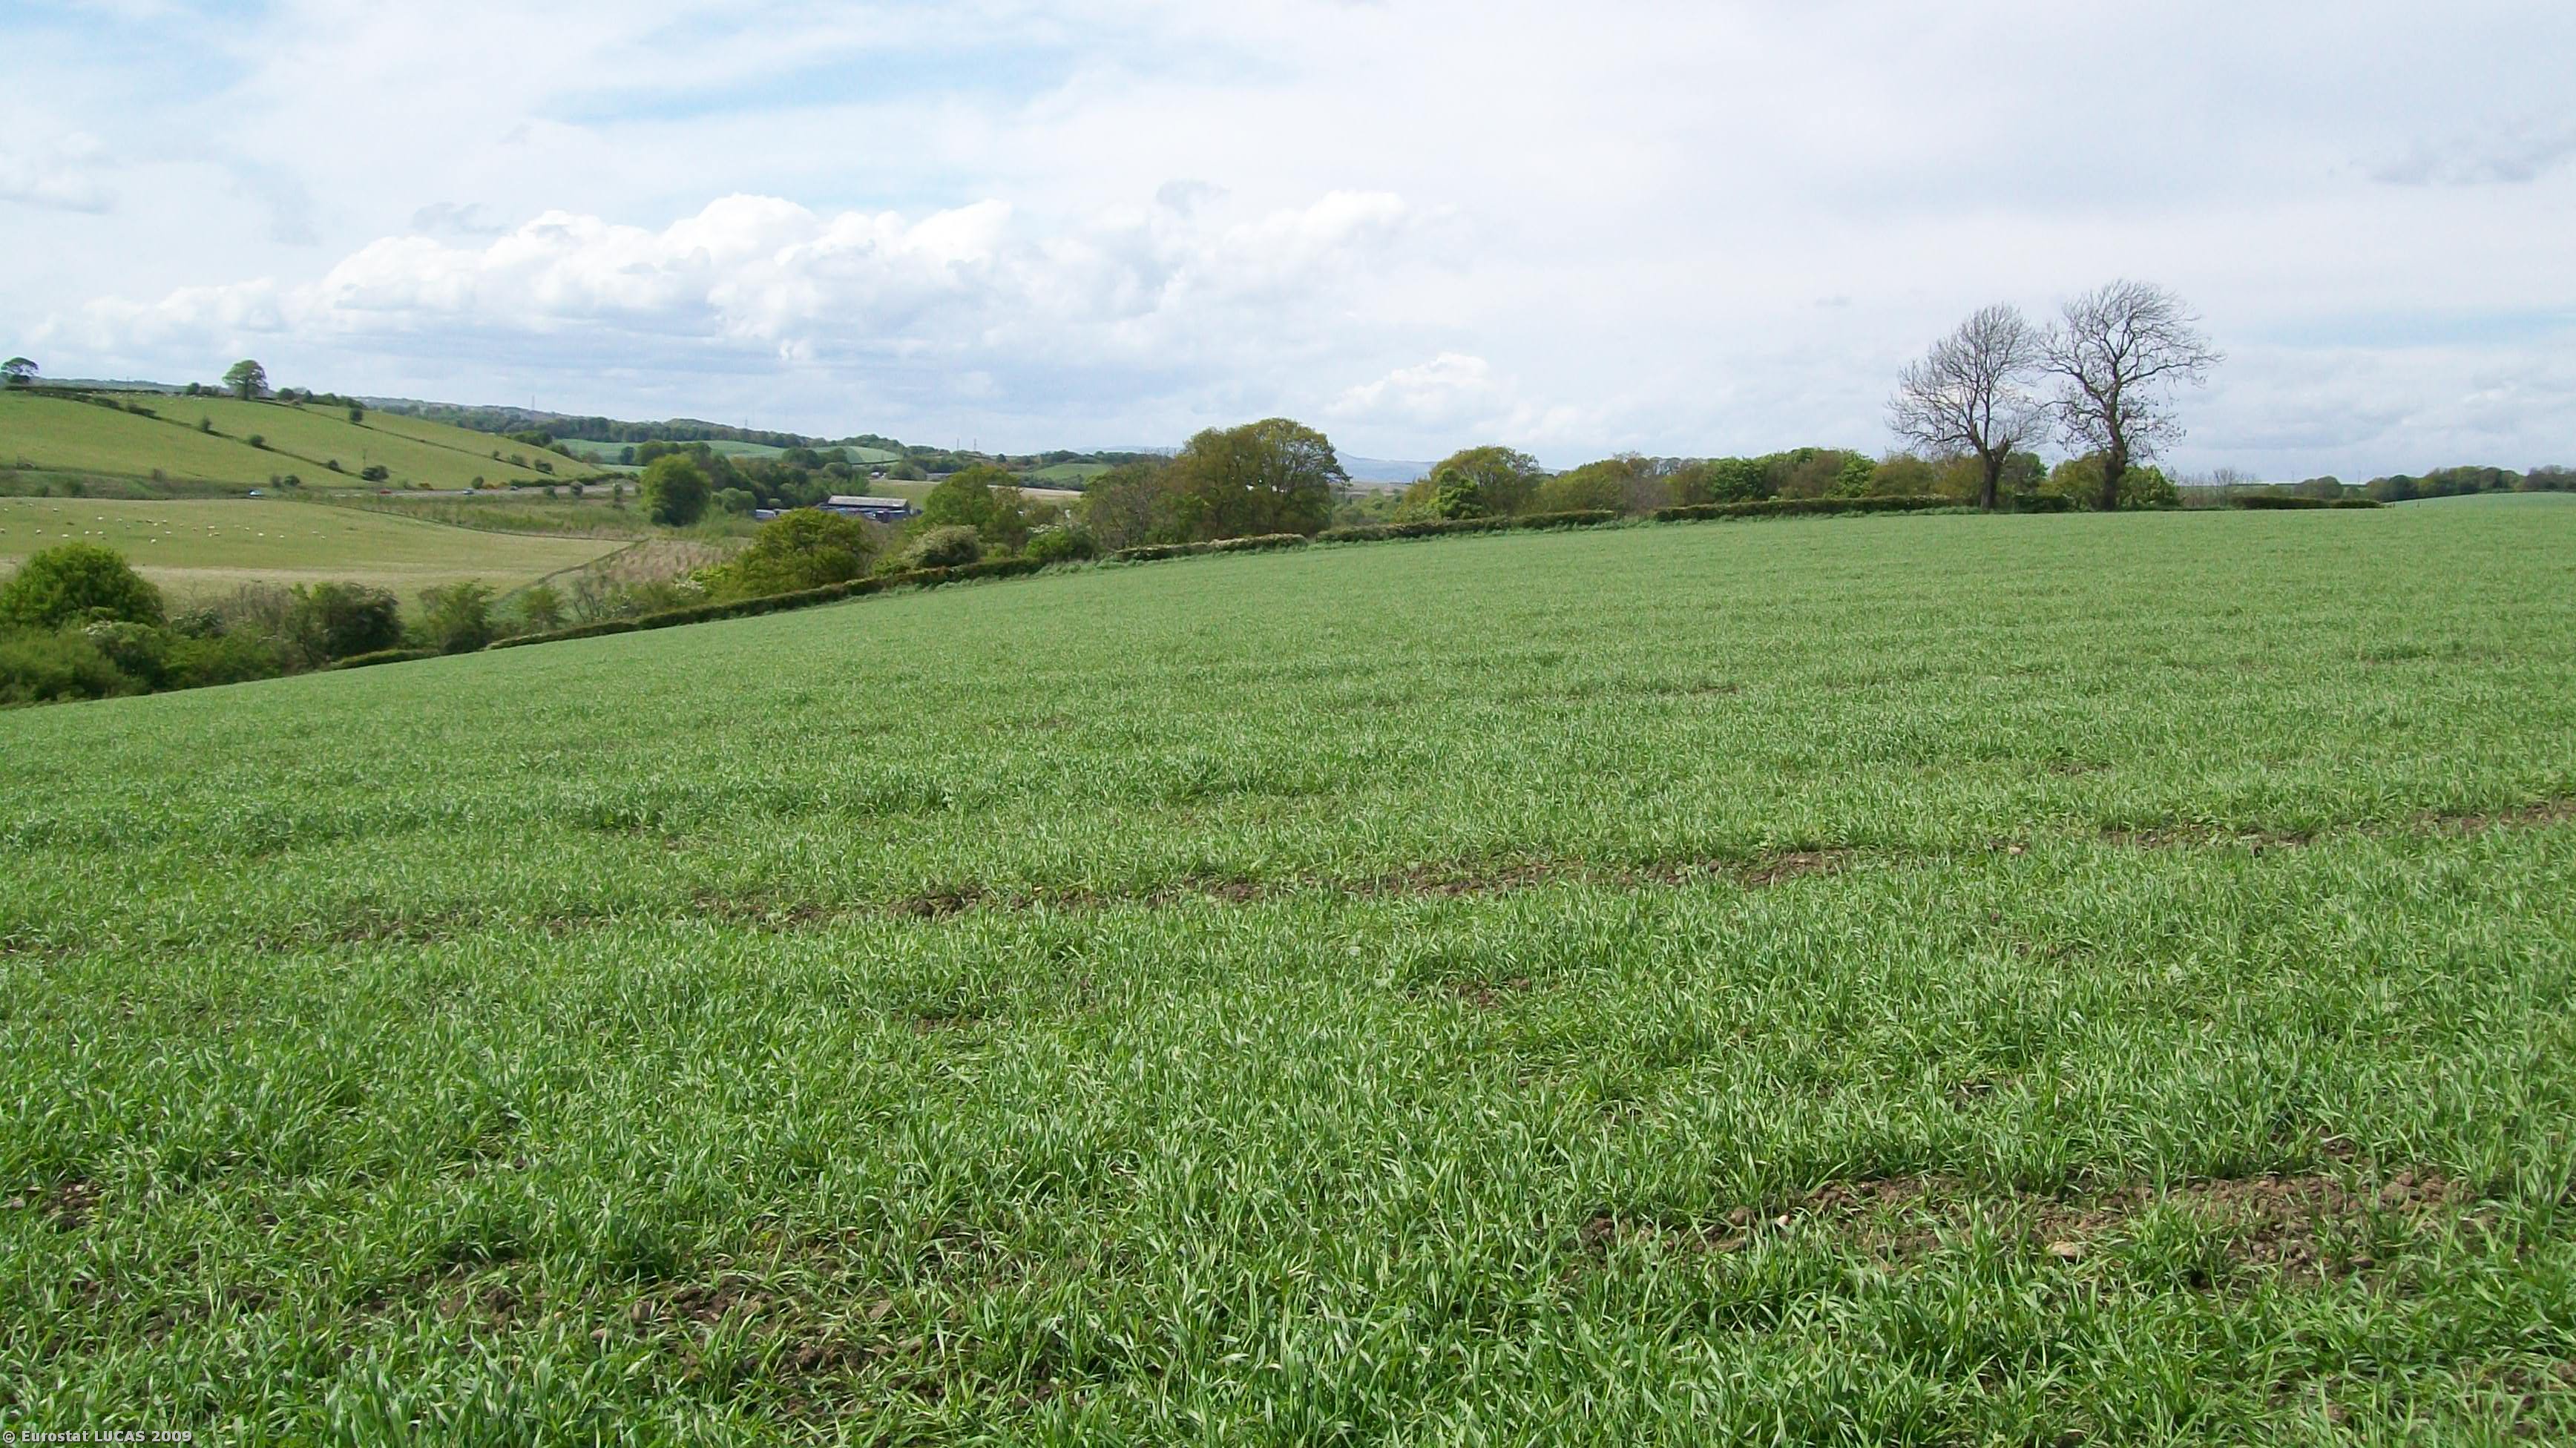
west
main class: Cropland
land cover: Barley
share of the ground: > 75 %
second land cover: Rape and turnip rape
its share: 50 - 75 %
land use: Agriculture (excluding fallow land and kitchen gardens)
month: May
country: GB
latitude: 55.9862
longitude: -3.6242
